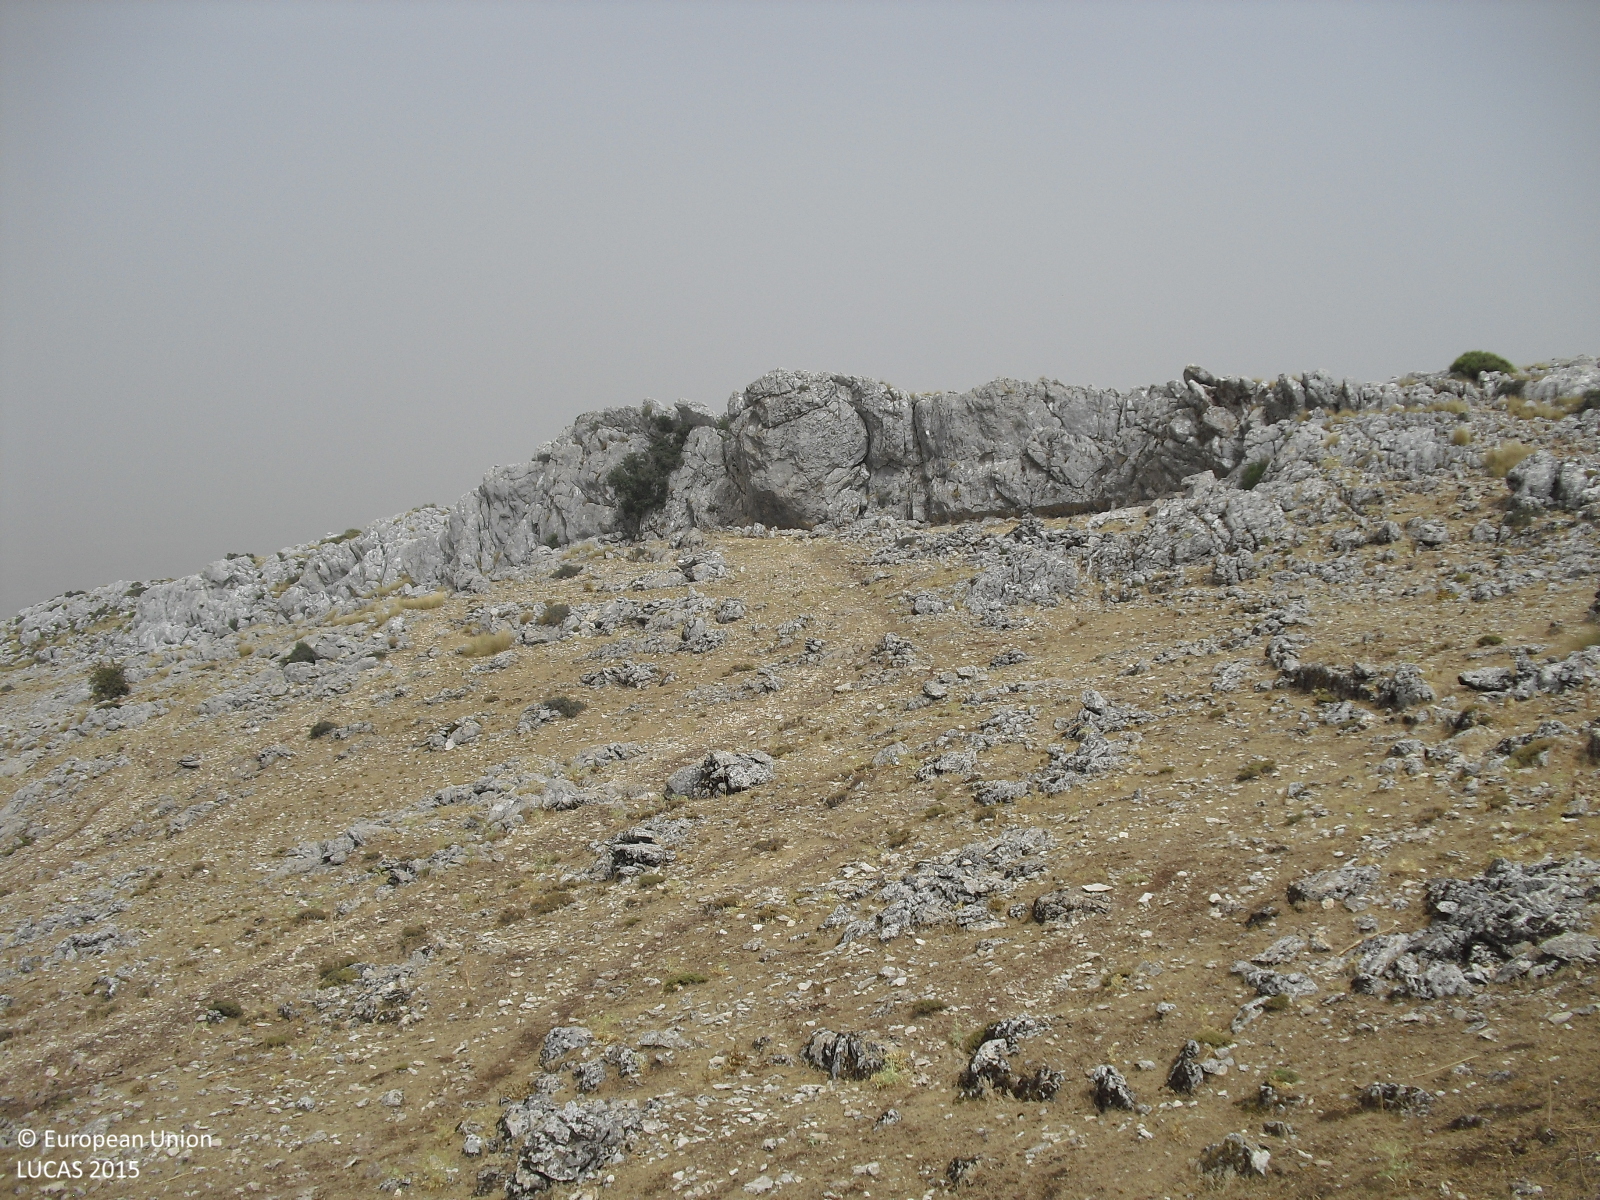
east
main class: Shrubland
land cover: Shrubland without tree cover
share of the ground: 10 - 25 %
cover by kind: herbaceous plants 40 %, consolidated bare surface 40 %, shrubs 20 %
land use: Agriculture (excluding fallow land and kitchen gardens)
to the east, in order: Shrubland without tree cover; Rock outcrops; Shrubland without tree cover
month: August
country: ES
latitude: 37.1226
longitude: -4.1642
